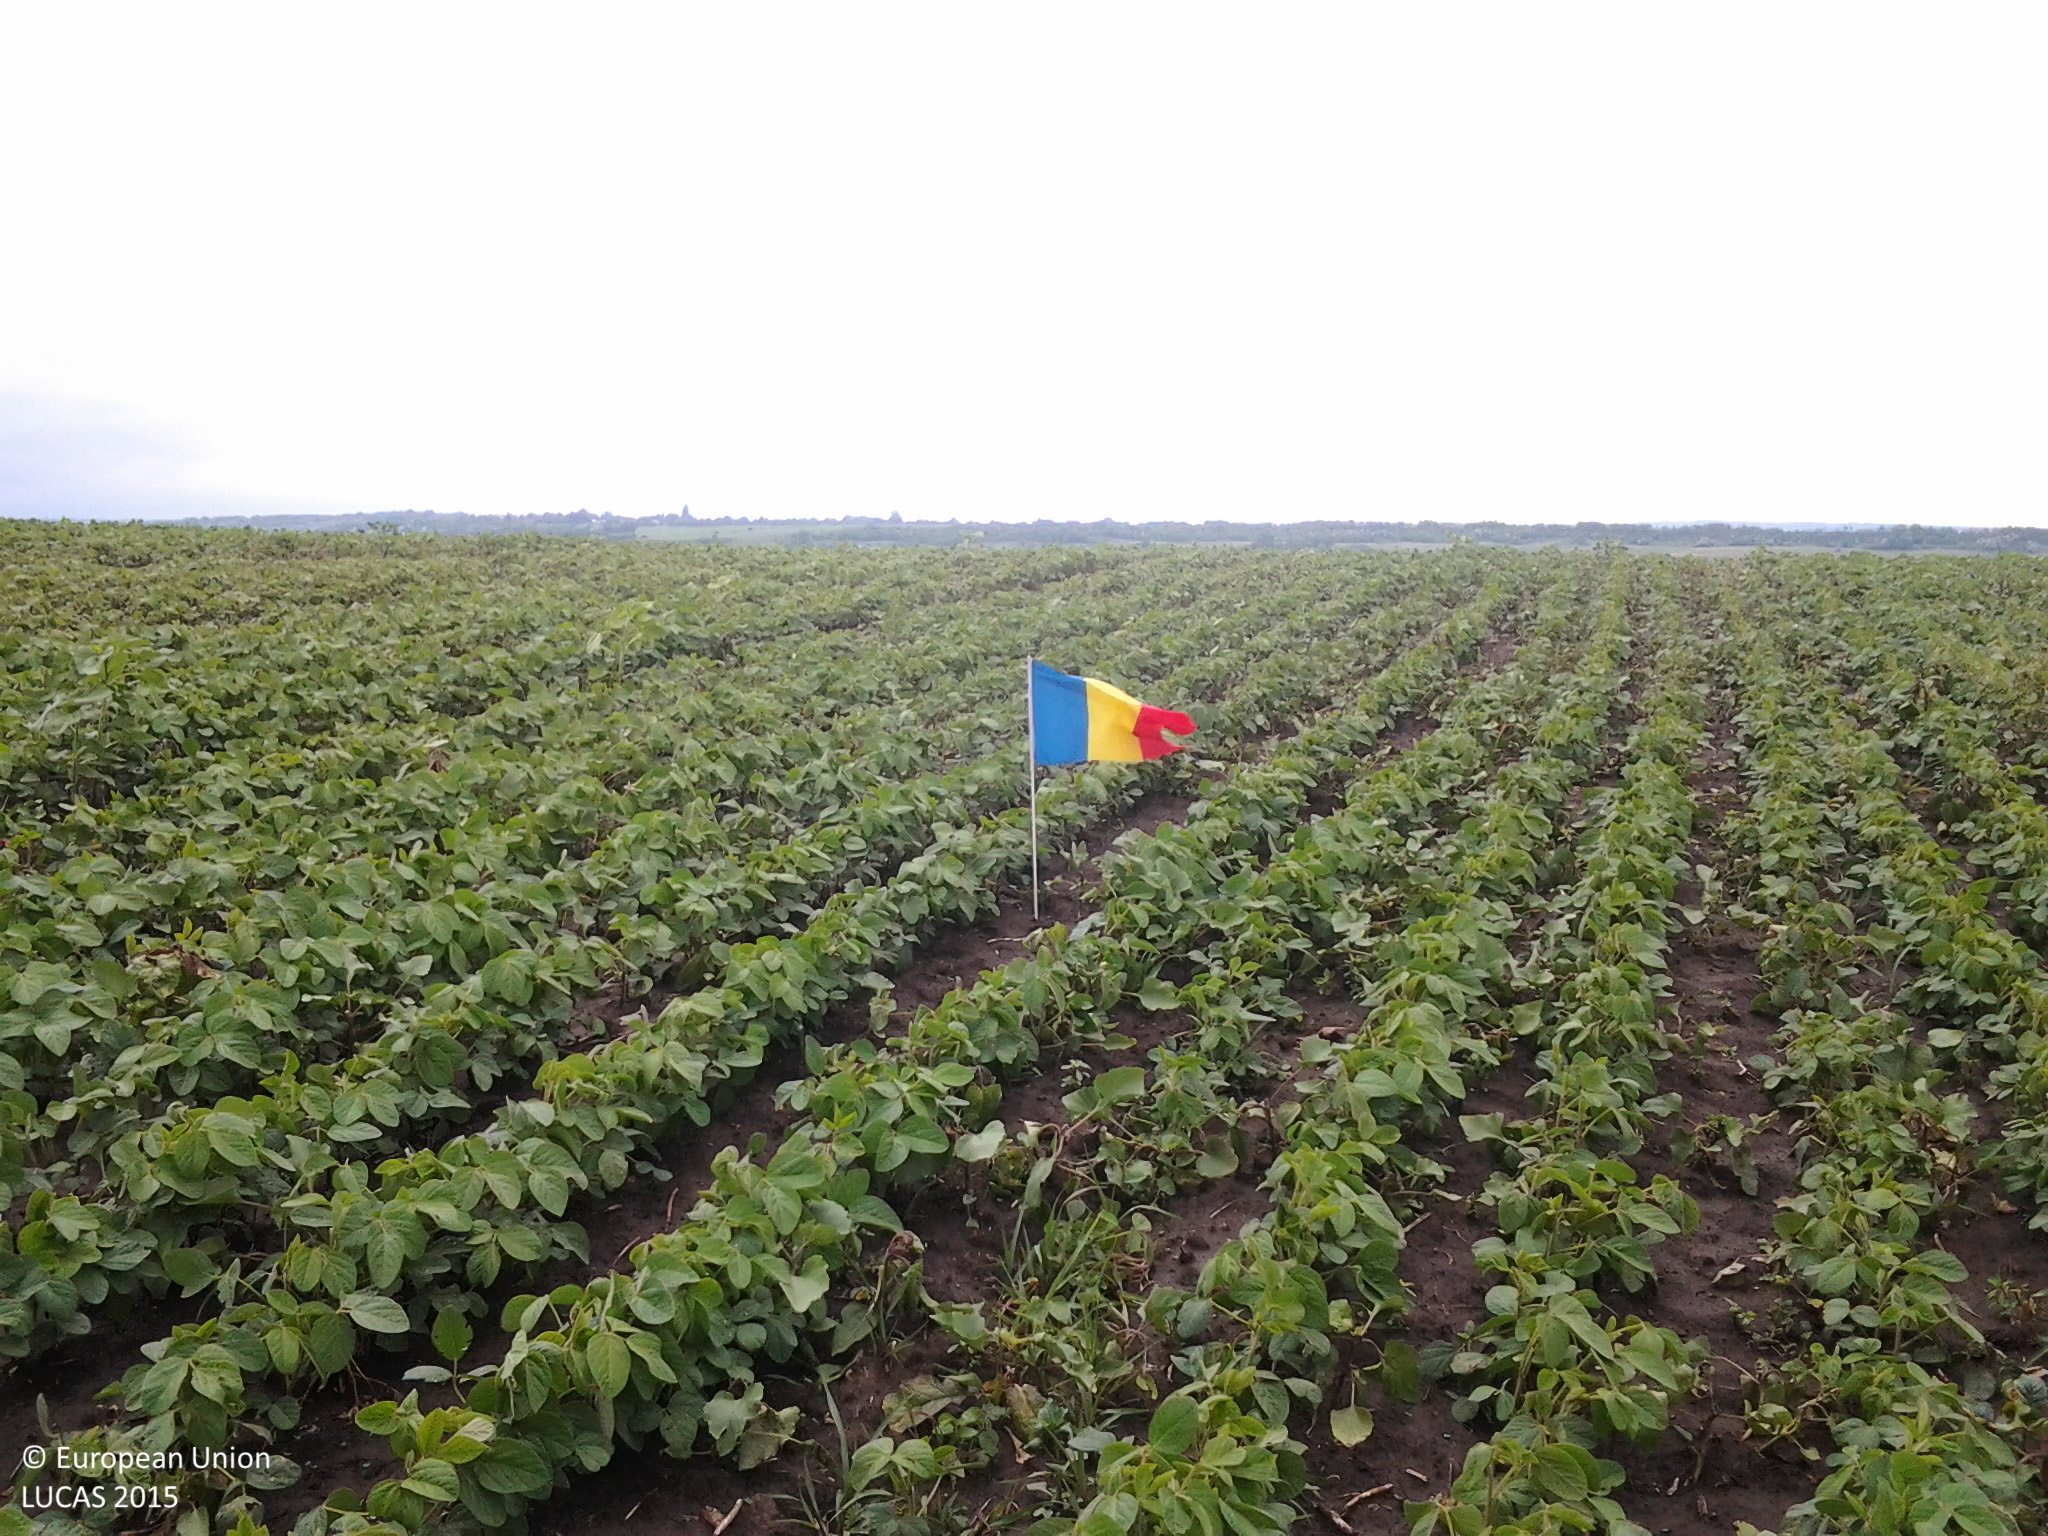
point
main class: Cropland
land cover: Soya
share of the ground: 50 - 75 %
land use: Agriculture (excluding fallow land and kitchen gardens)
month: June
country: RO
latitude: 47.9218
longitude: 26.5122
